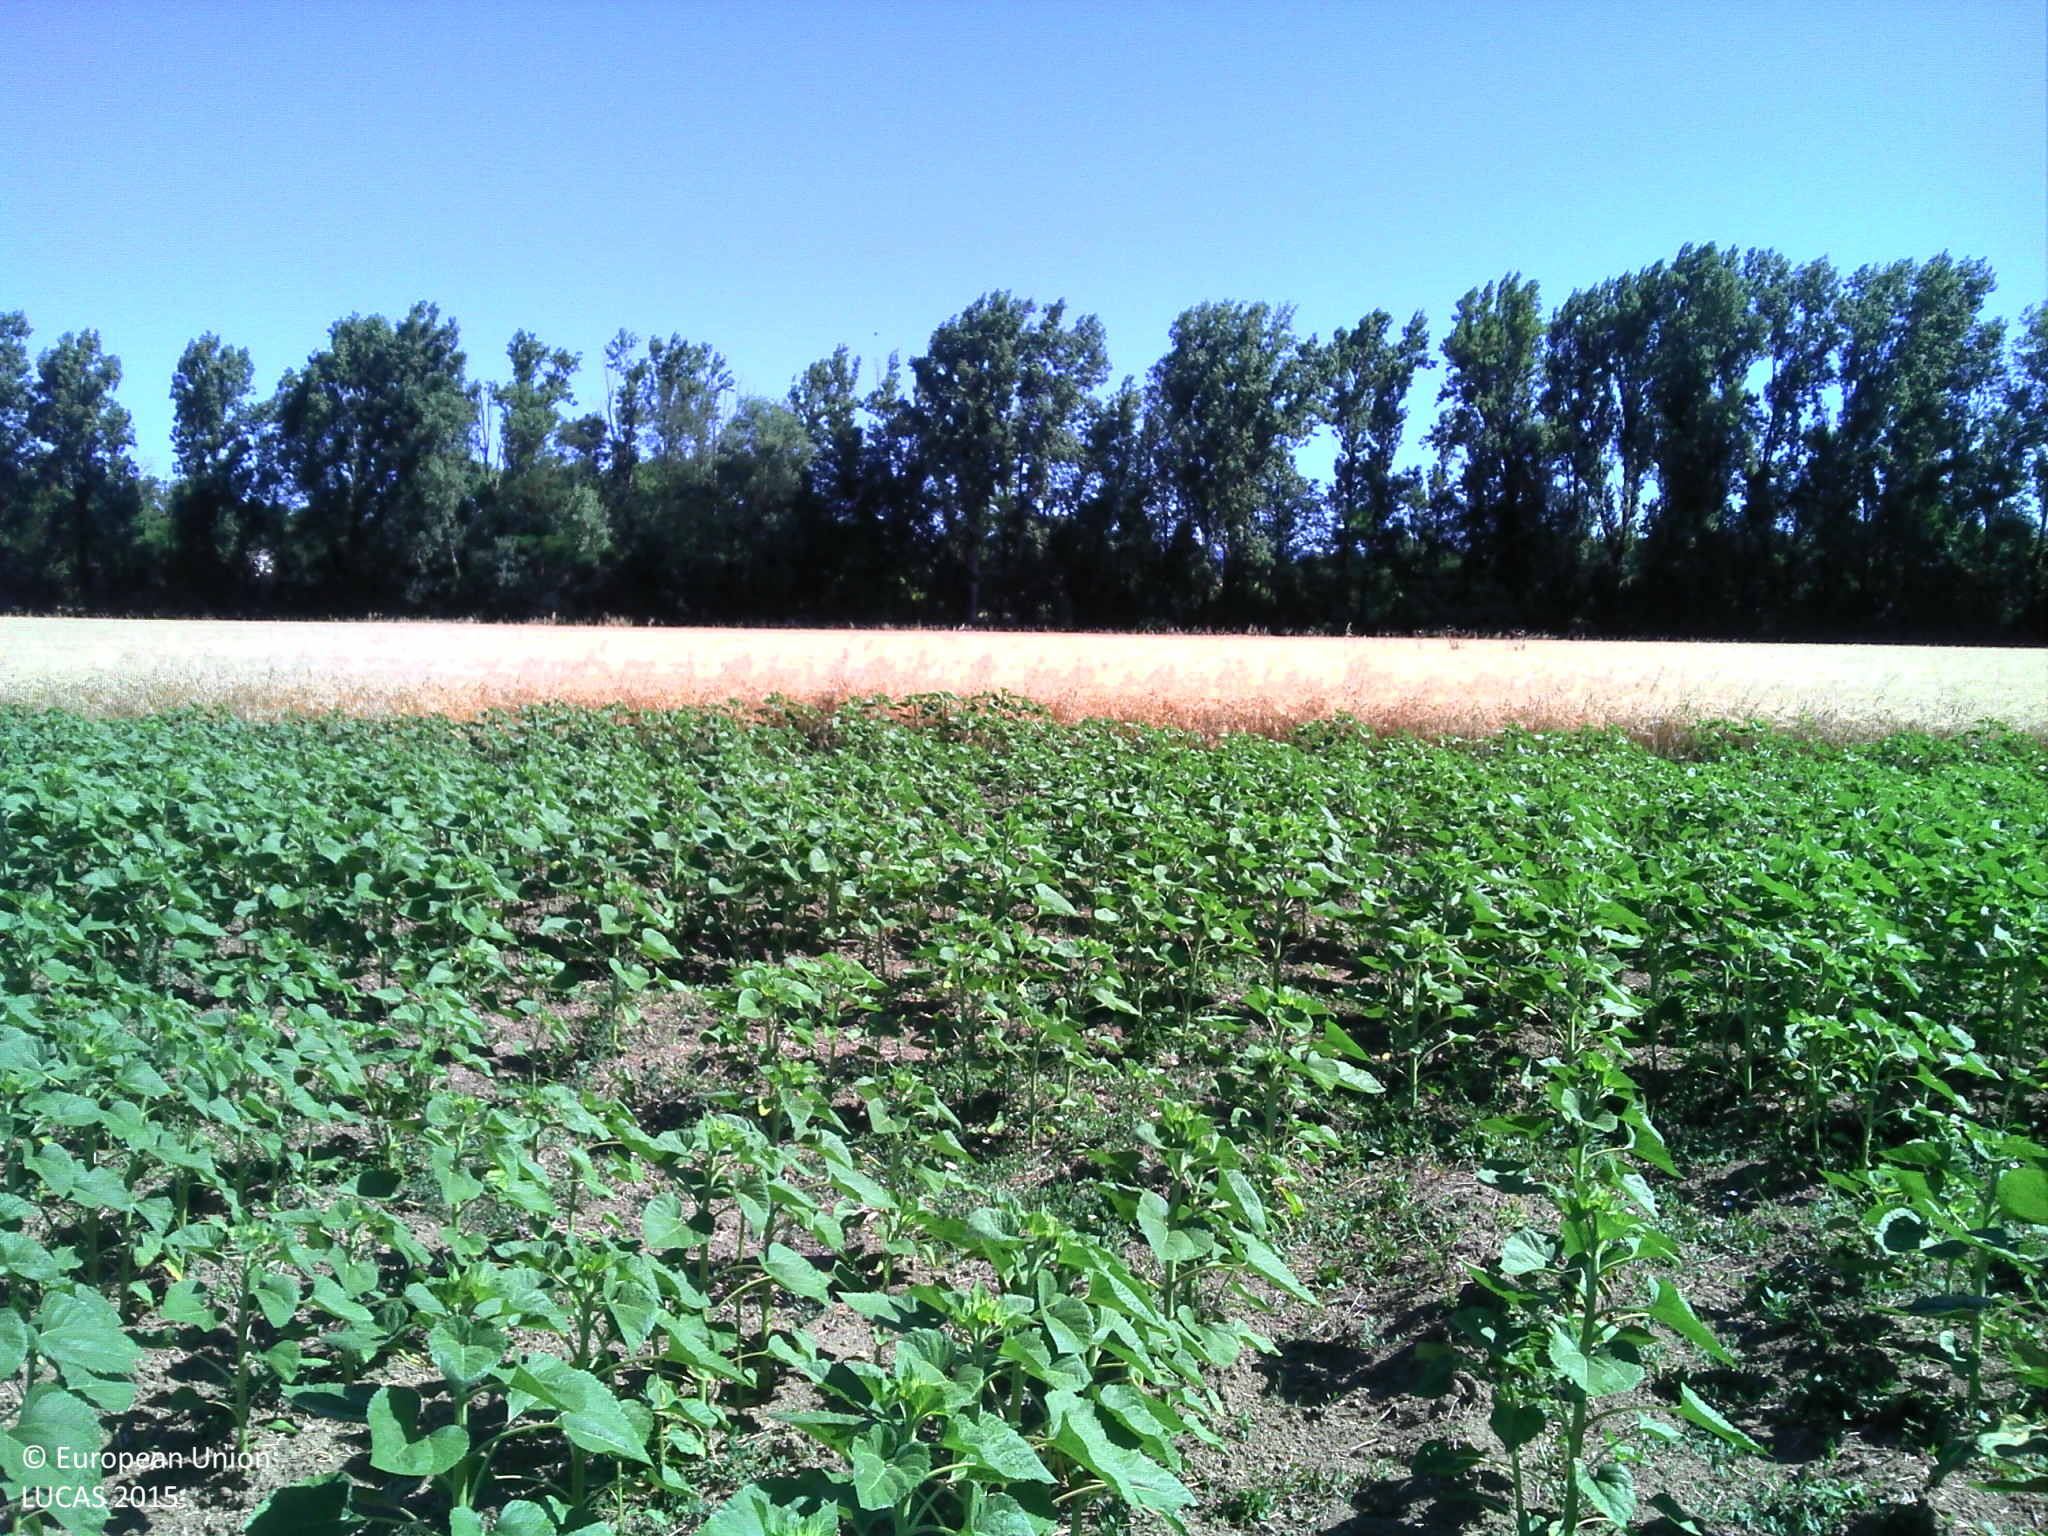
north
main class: Cropland
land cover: Sunflower
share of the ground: 50 - 75 %
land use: Agriculture (excluding fallow land and kitchen gardens)
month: June
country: FR
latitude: 43.2828
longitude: 2.0335
